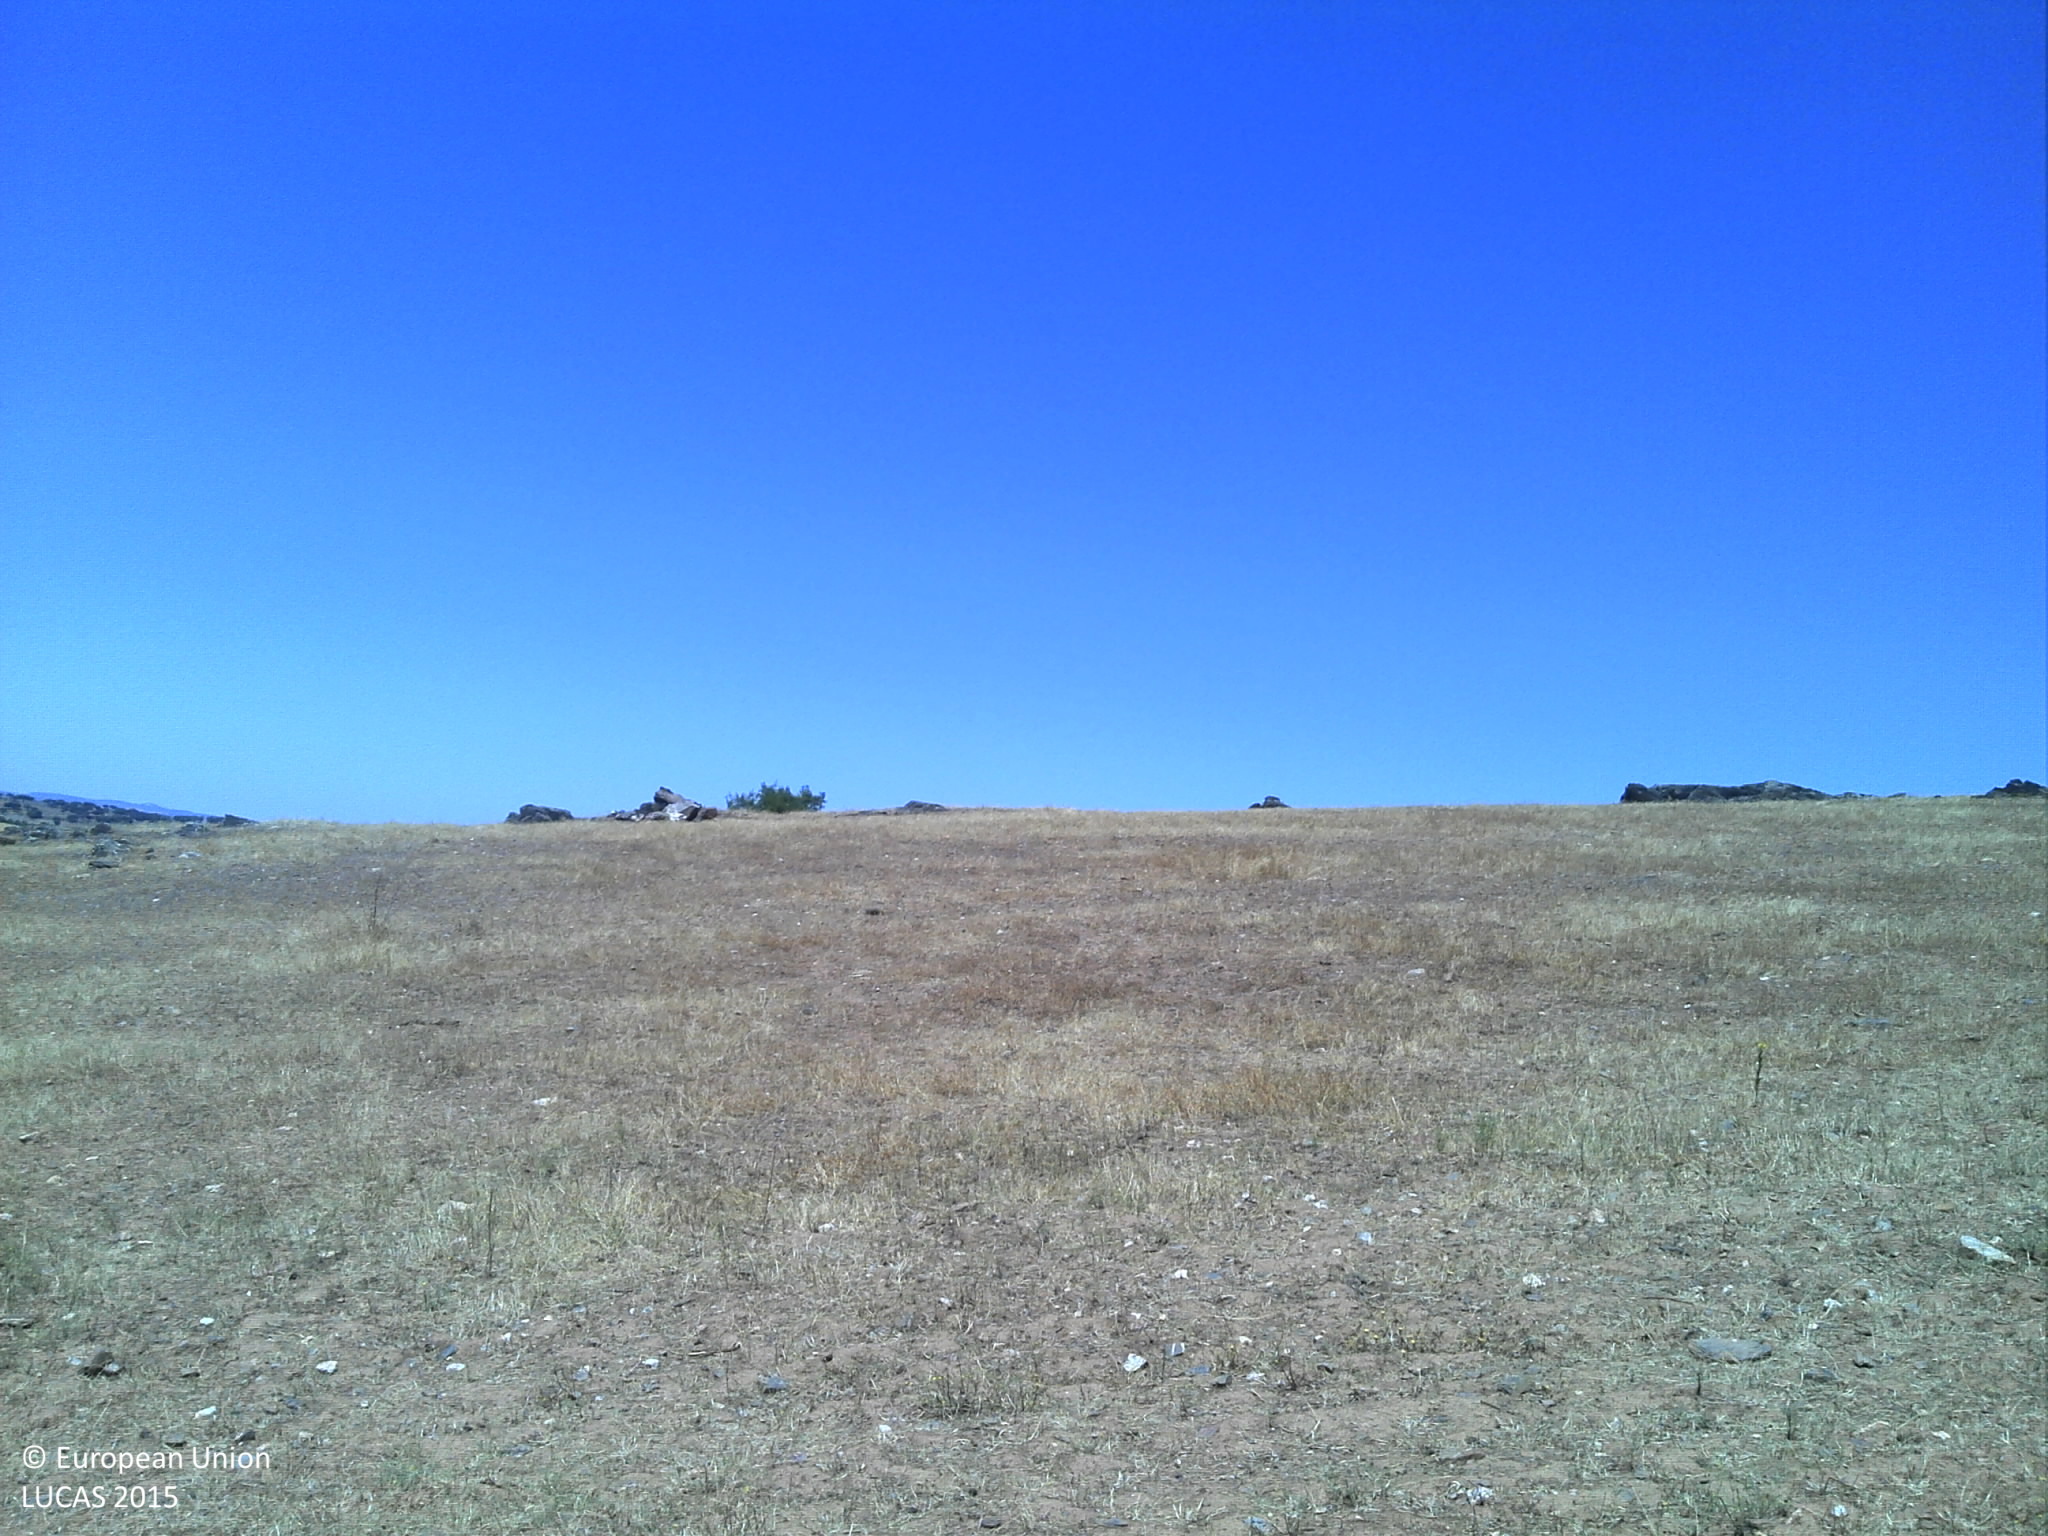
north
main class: Grassland
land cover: Grassland without tree/shrub cover
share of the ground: 25 - 50 %
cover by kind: unconsolidated bare surface 75 %, herbaceous plants 25 %
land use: Agriculture (excluding fallow land and kitchen gardens)
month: July
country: PT
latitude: 38.9498
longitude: -7.5418
